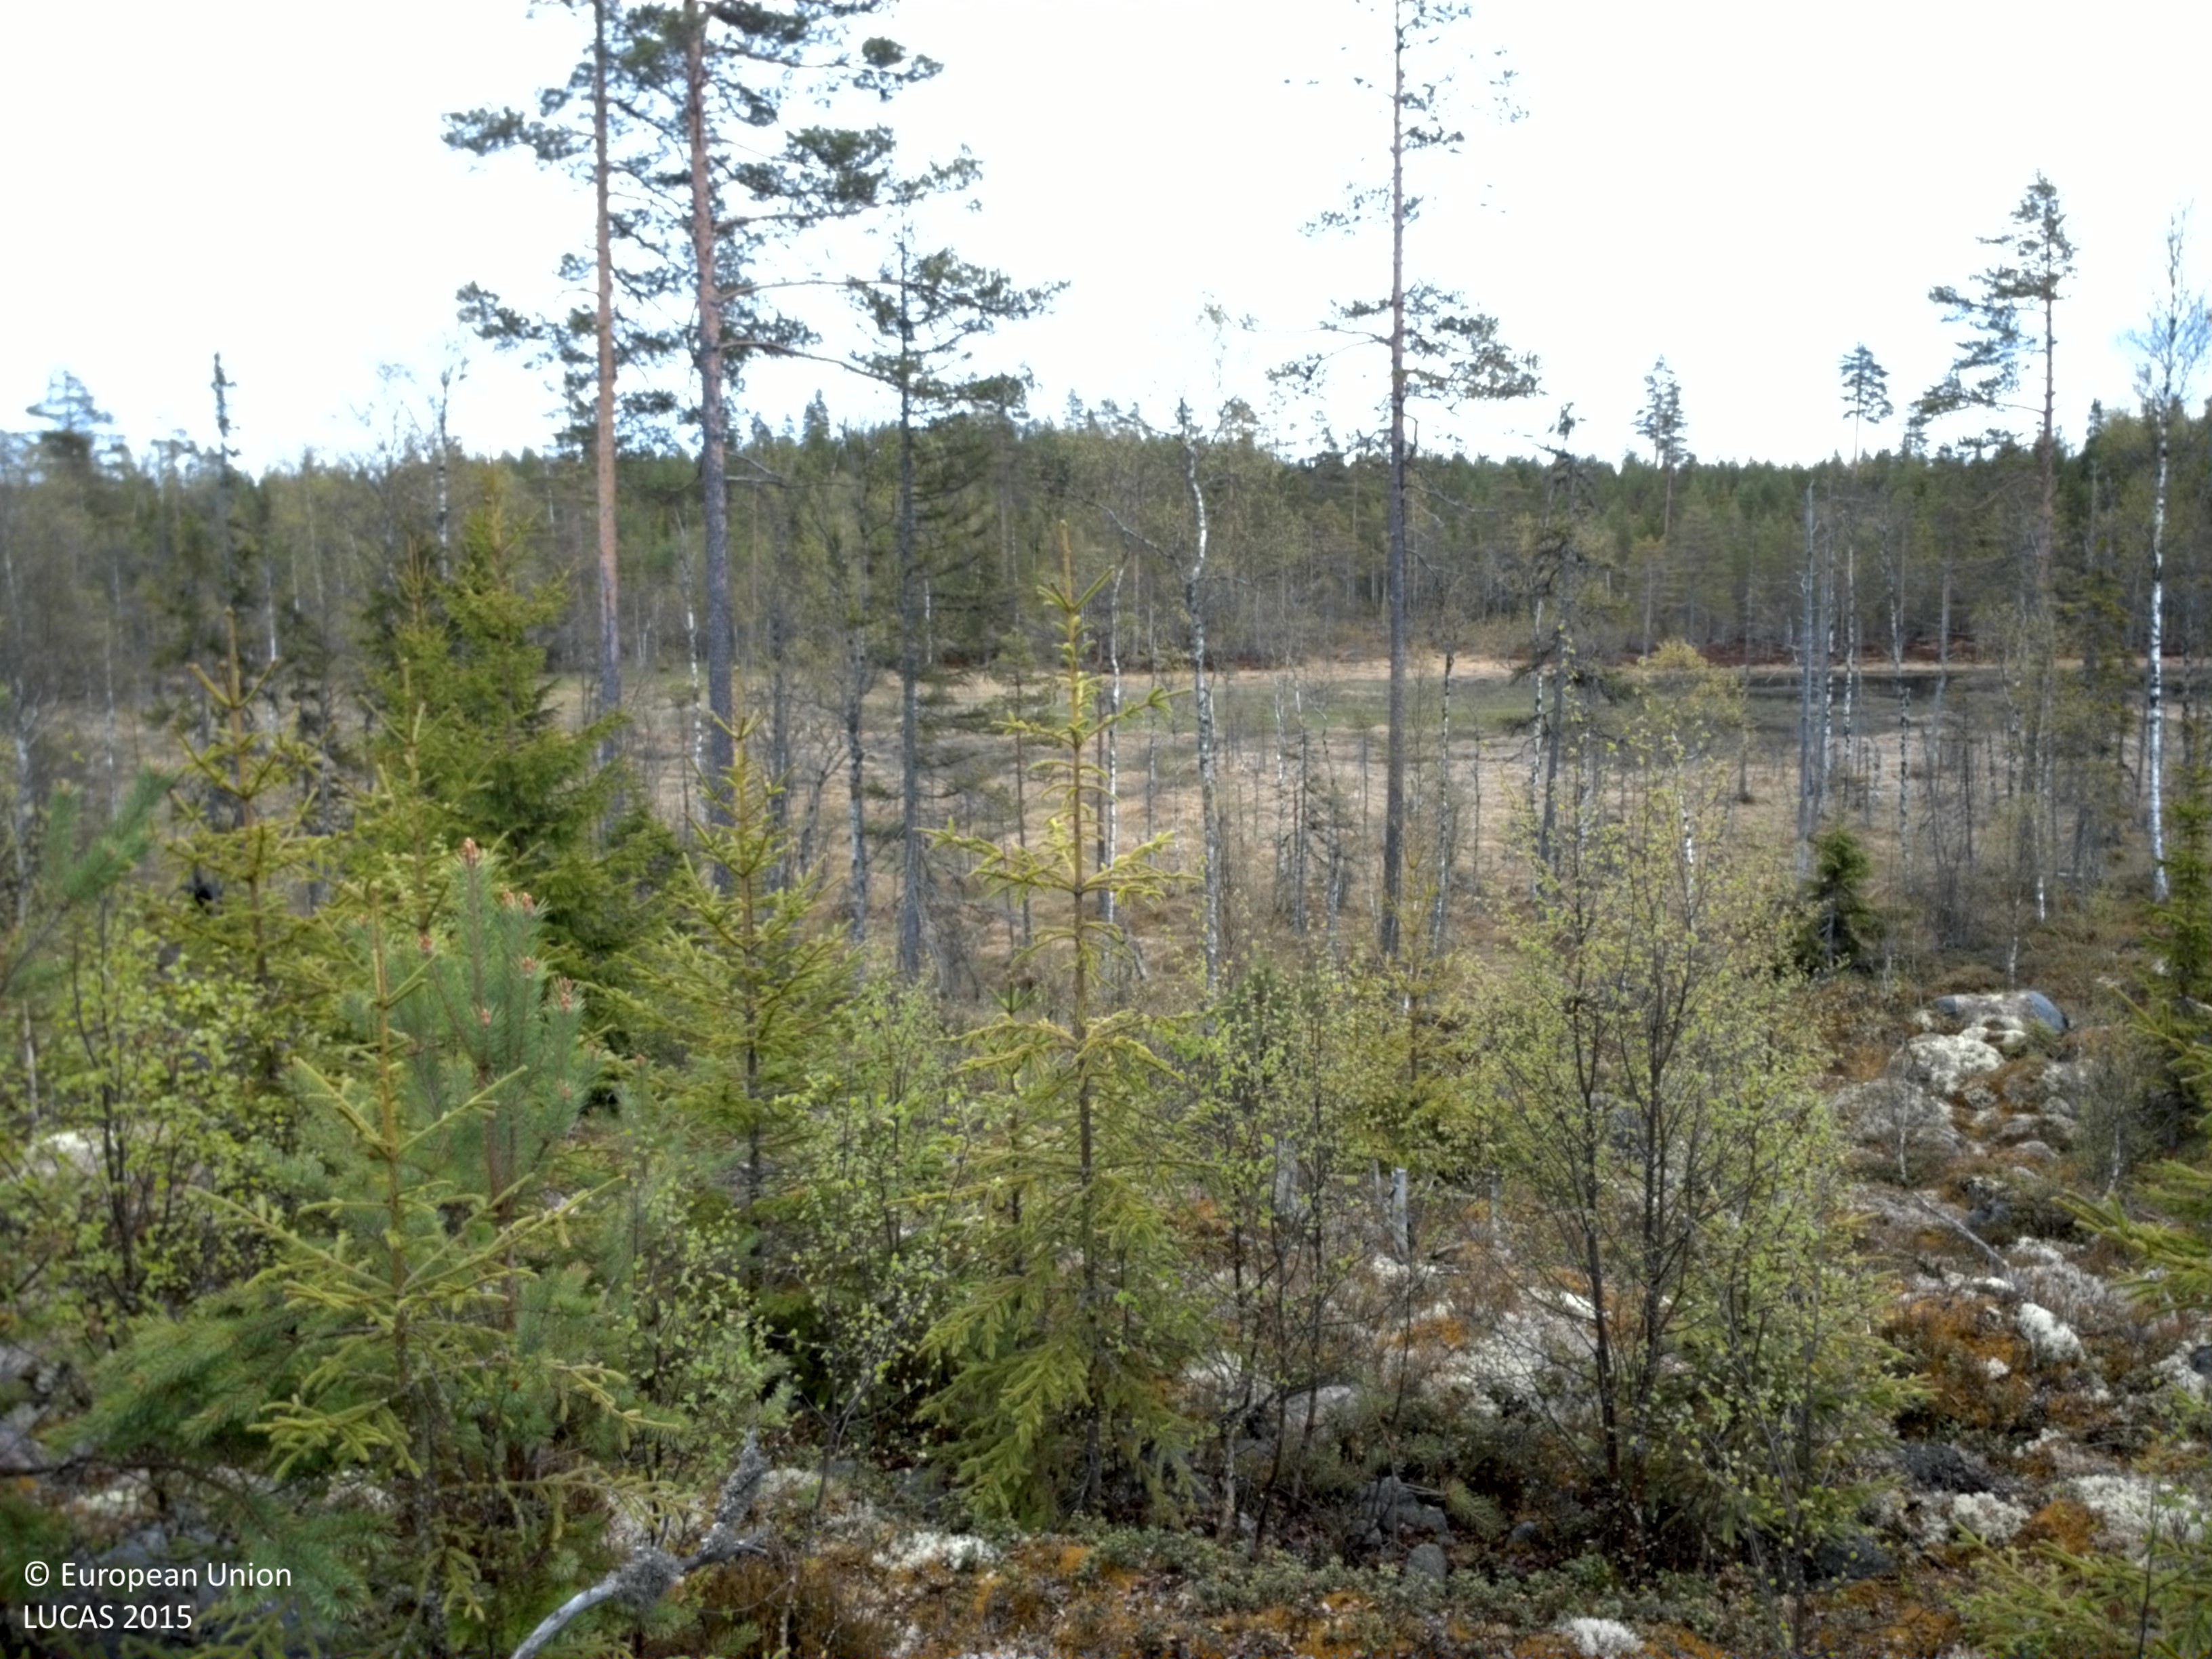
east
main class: Woodland
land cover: Spruce dominated mixed woodland
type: boreal forest
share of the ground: > 75 %
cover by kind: coniferous forest trees 60 %, broadleaved forest trees 25 %, herbaceous plants 10 %, lichens and mosses 5 %
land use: Forestry
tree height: < 5 m
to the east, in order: Spruce dominated mixed woodland; Other mixed woodland; Peatbogs; Rivers and streams; Peatbogs; Rivers and streams; Peatbogs; Spruce dominated mixed woodland
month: May
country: SE
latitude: 61.1096
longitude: 15.3108
